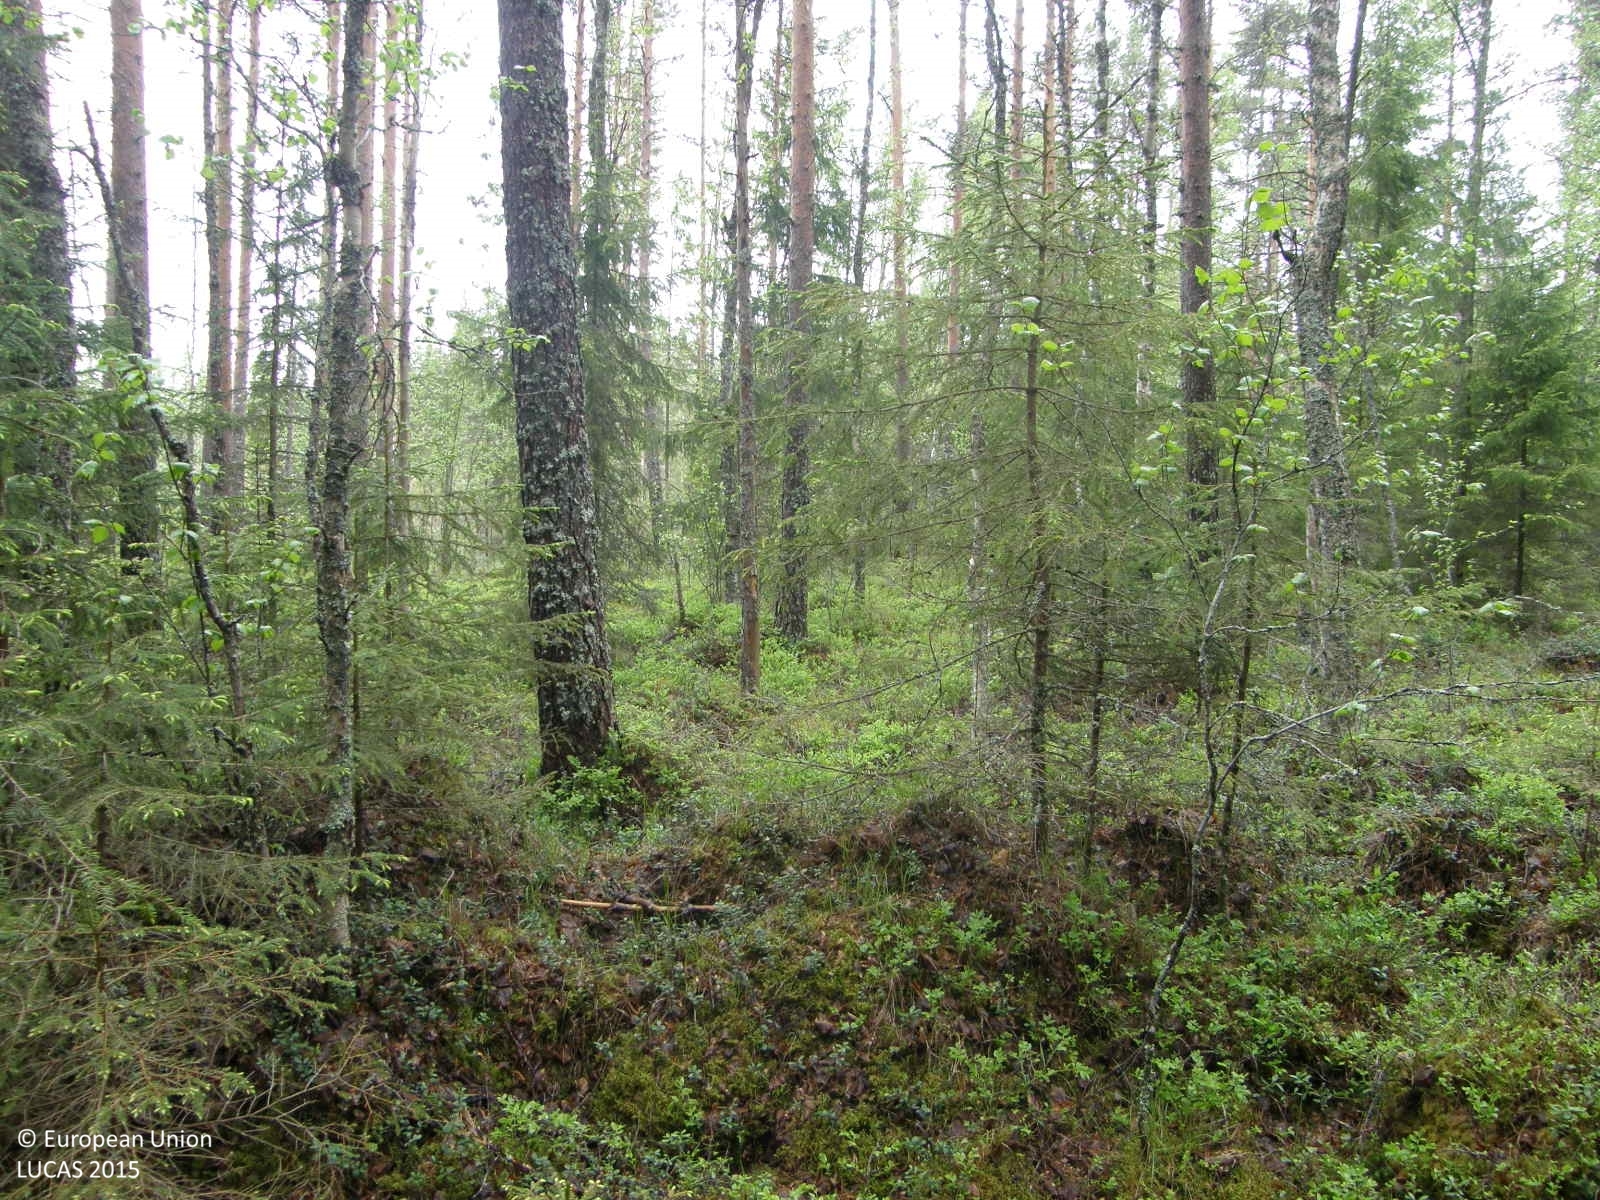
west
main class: Woodland
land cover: Other mixed woodland
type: boreal forest
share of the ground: > 75 %
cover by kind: coniferous forest trees 60 %, broadleaved forest trees 25 %, shrubs 15 %
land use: Forestry
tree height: > 5 m
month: June
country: FI
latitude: 62.0395
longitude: 21.7695
